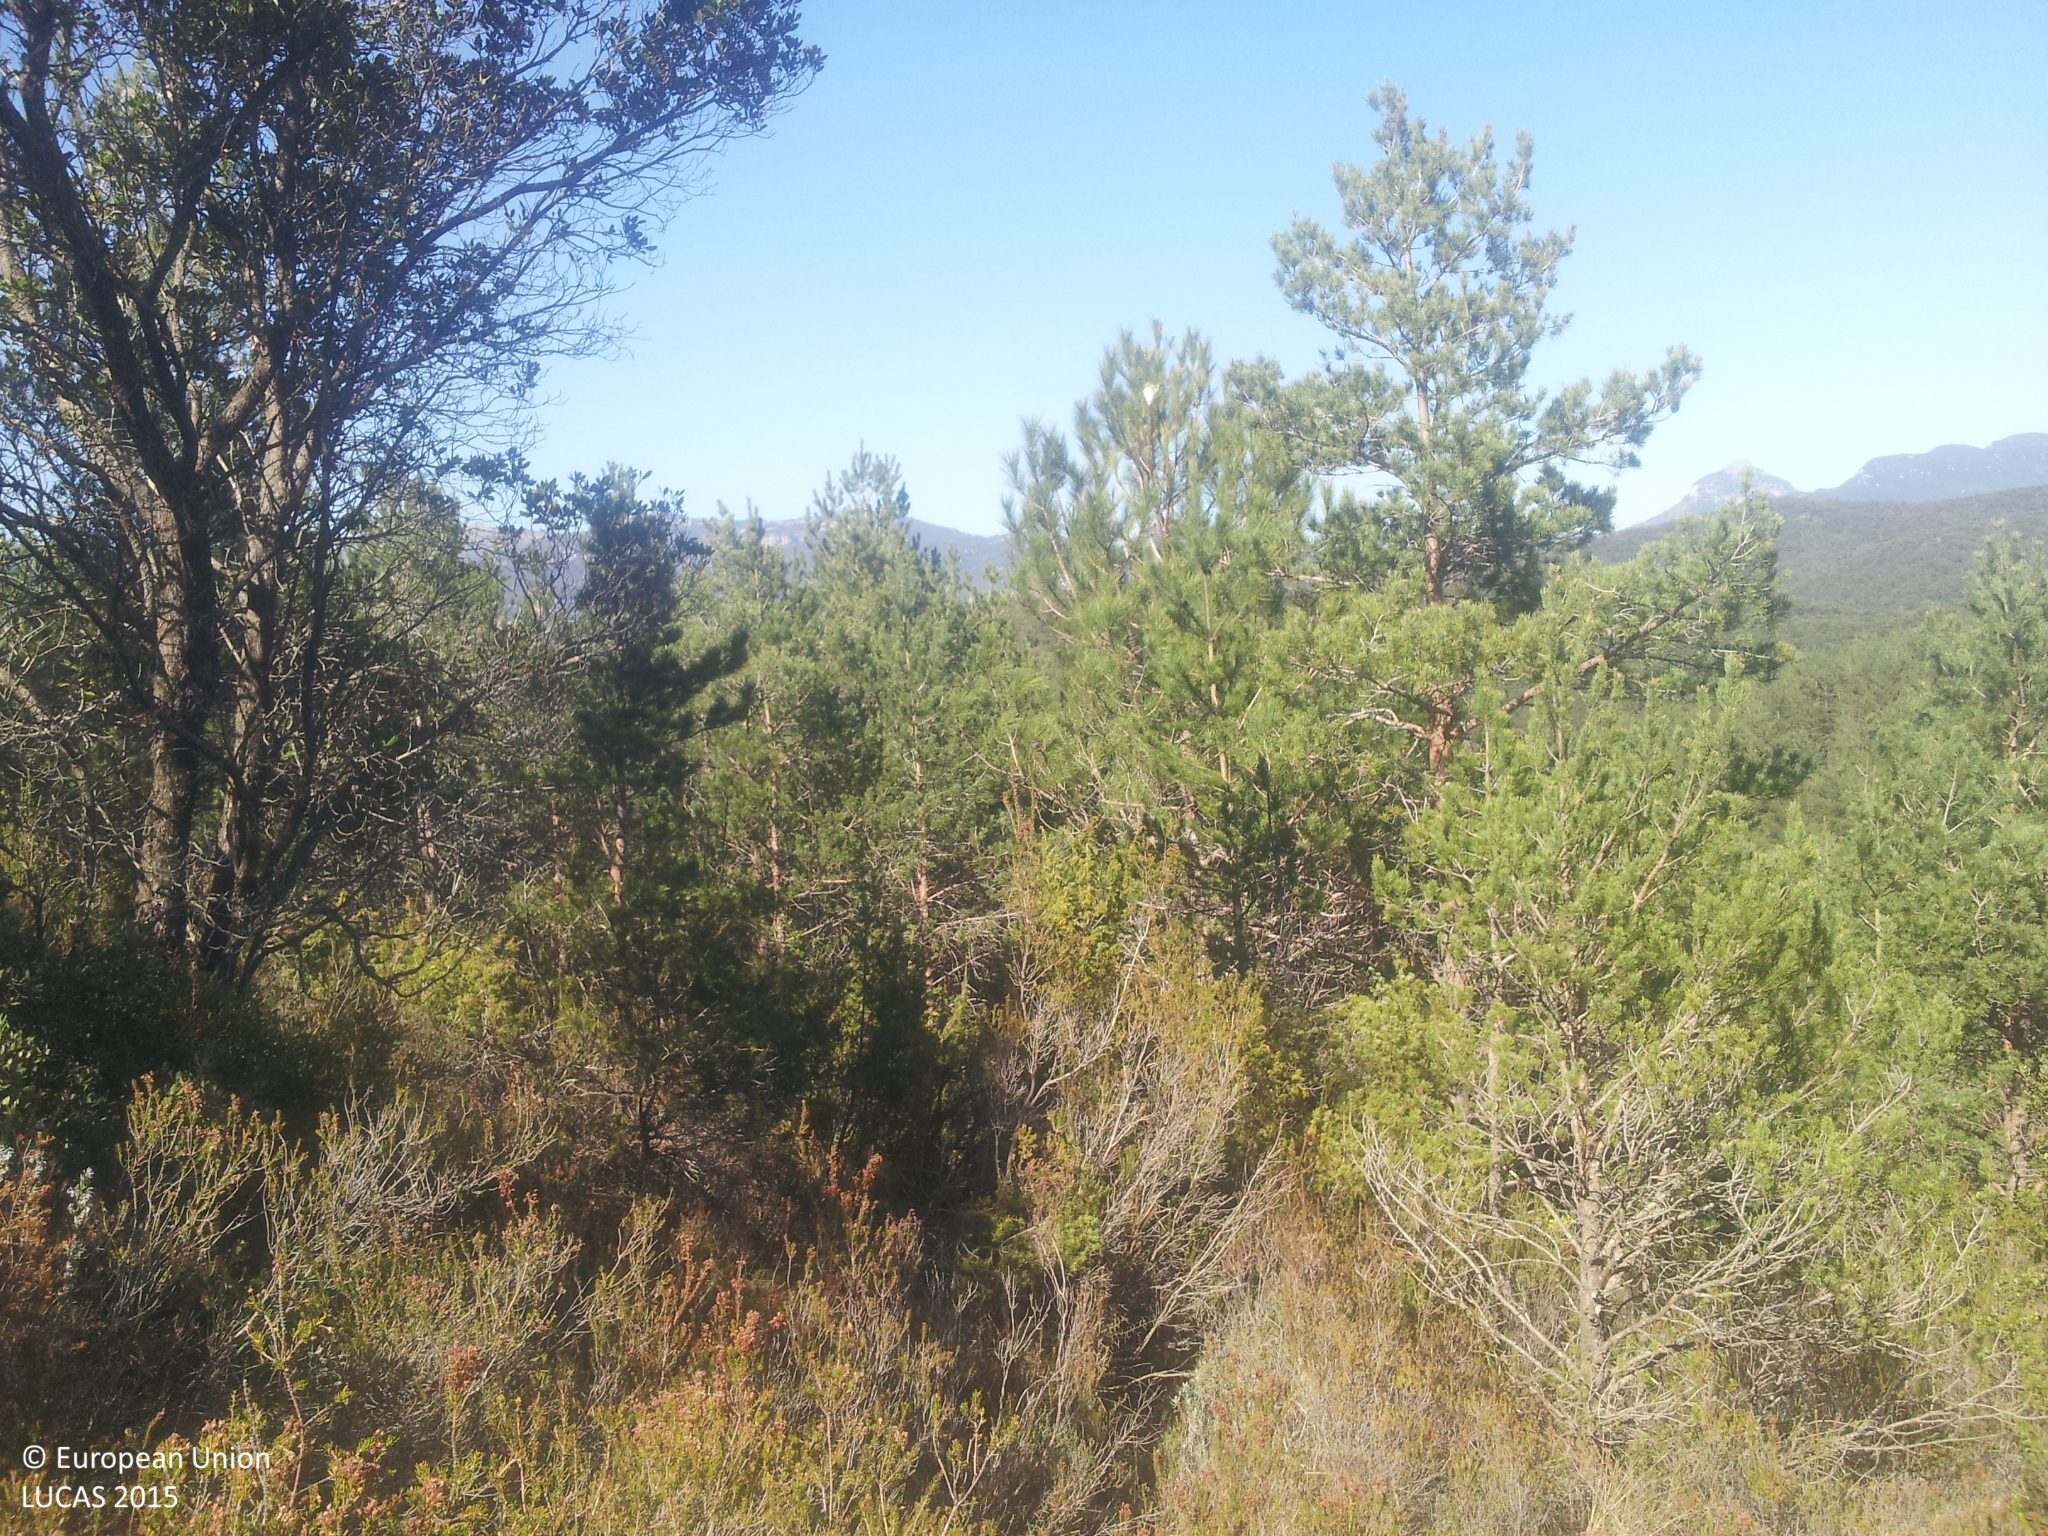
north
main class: Woodland
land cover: Pine dominated coniferous woodland
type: coniferous forest of the mediterranean region
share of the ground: 50 - 75 %
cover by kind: coniferous forest trees 70 %, shrubs 30 %
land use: Forestry
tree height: > 5 m
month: April
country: ES
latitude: 42.2514
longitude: 2.5352
